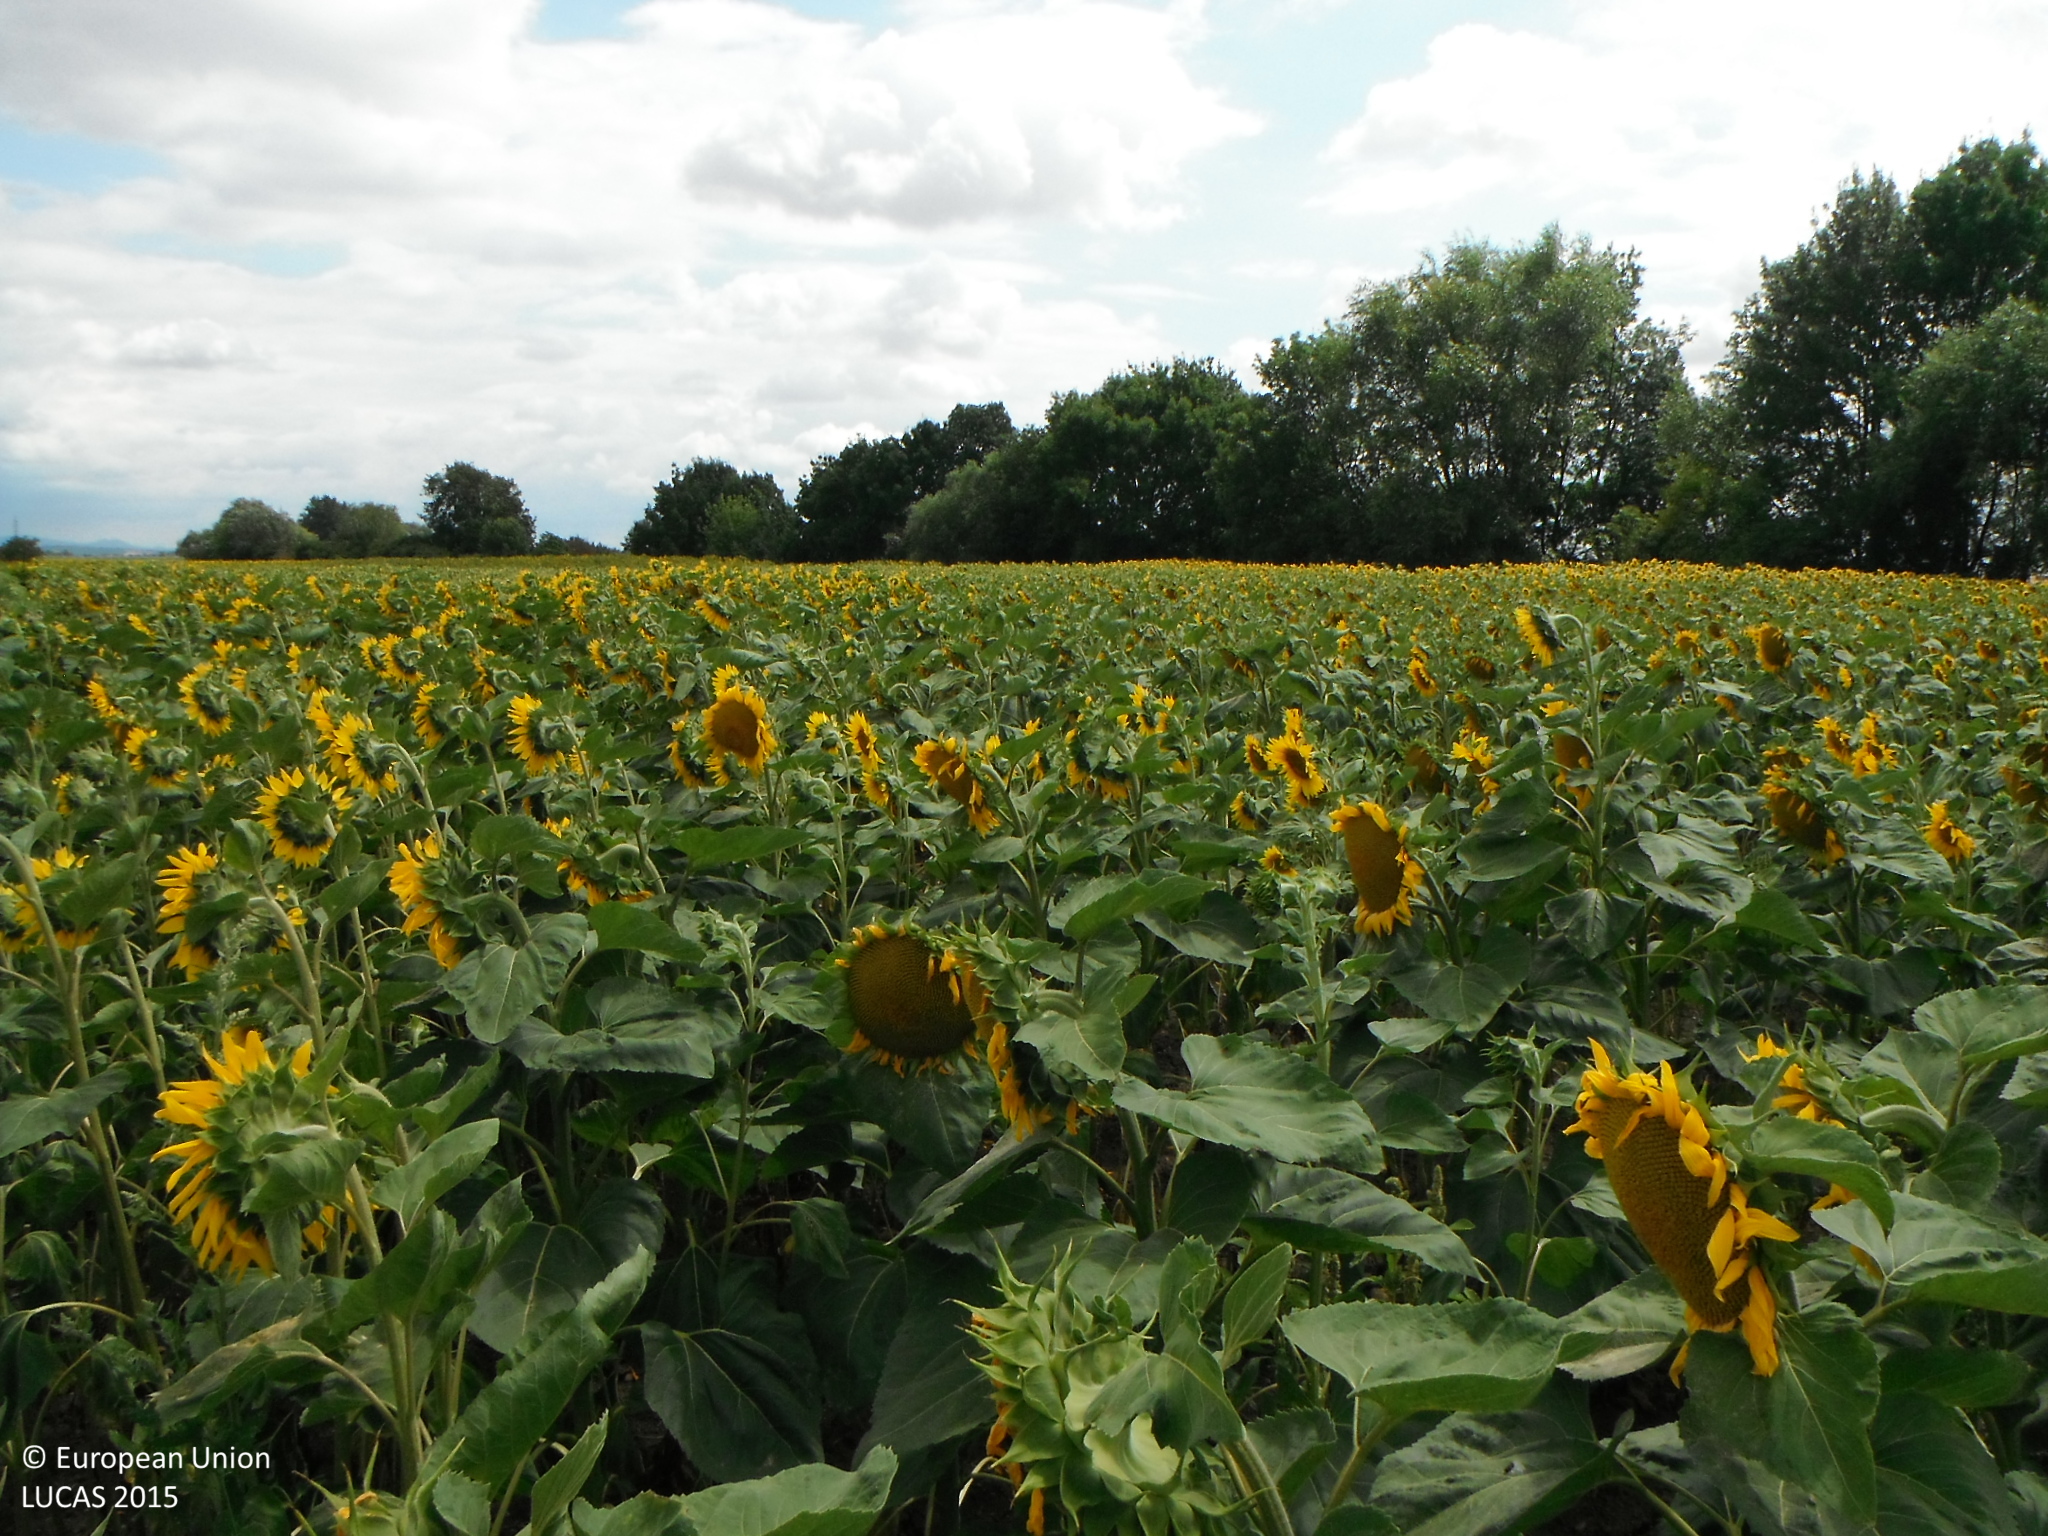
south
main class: Cropland
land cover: Sunflower
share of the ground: > 75 %
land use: Agriculture (excluding fallow land and kitchen gardens)
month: July
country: SK
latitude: 48.0844
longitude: 18.6217
